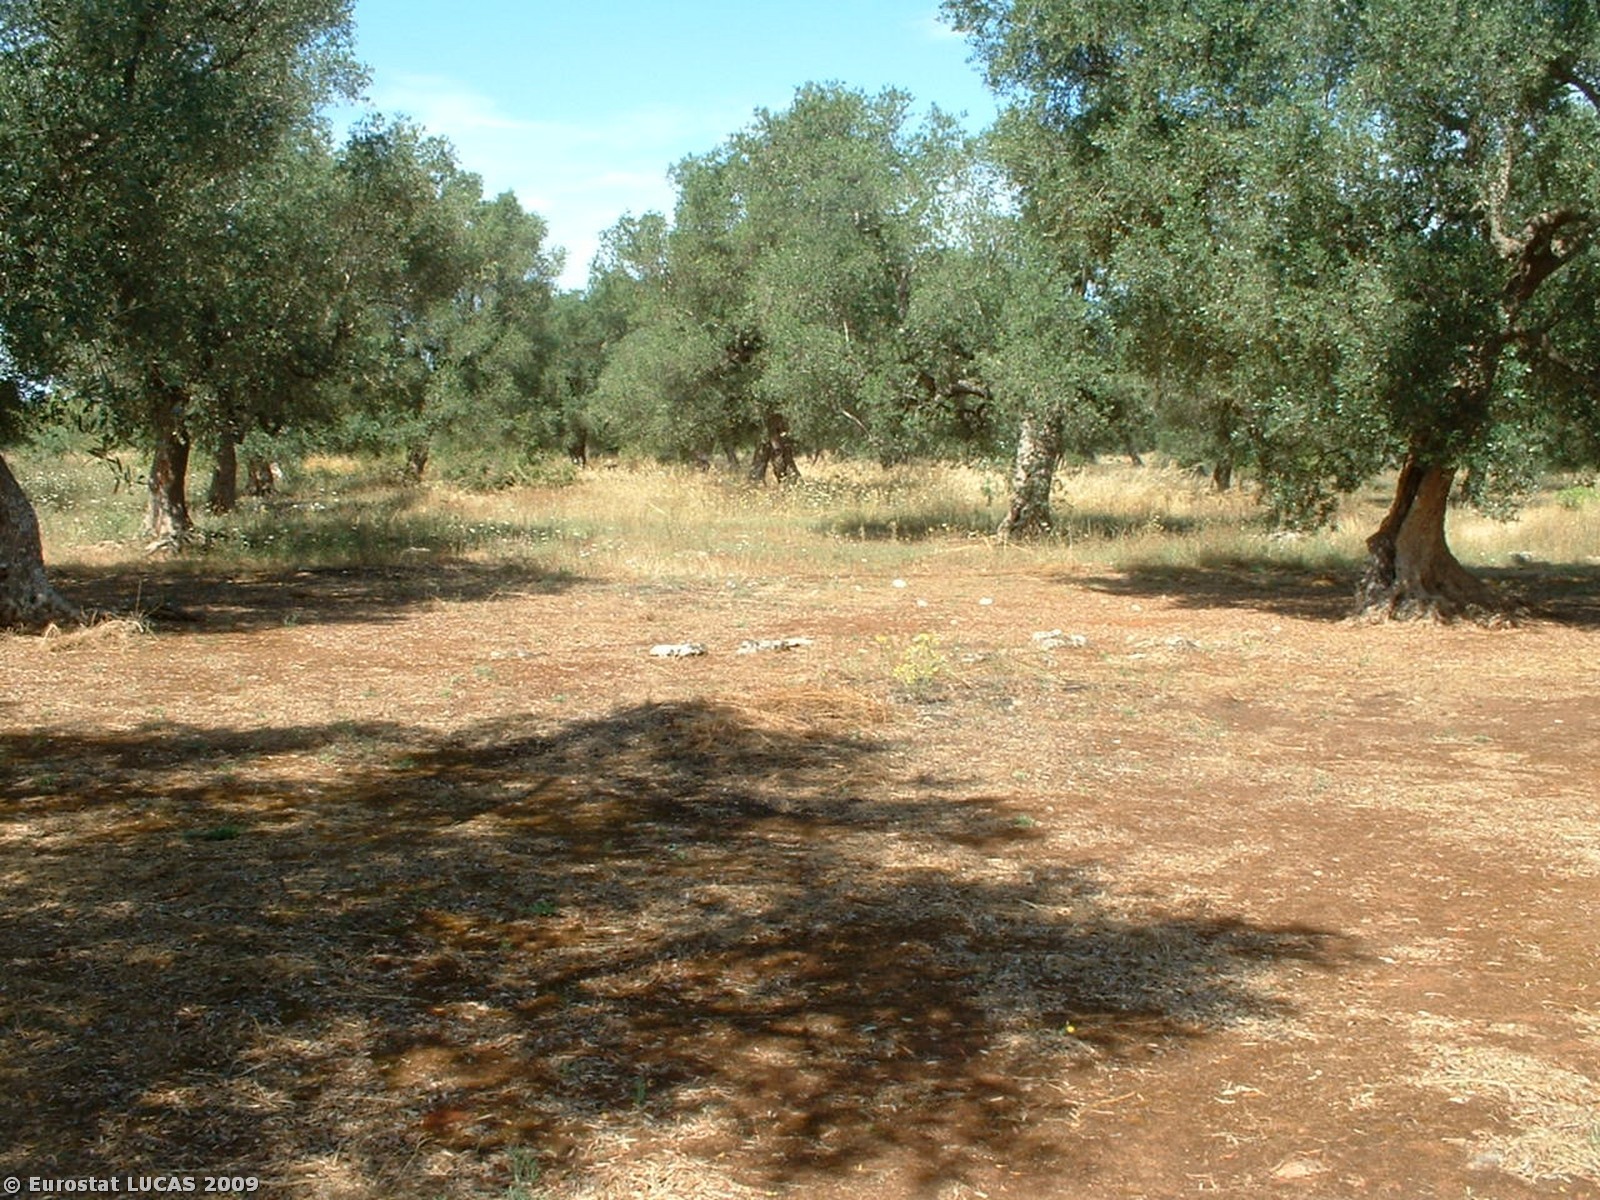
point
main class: Cropland
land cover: Olive groves
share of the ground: 50 - 75 %
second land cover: Spontaneously vegetated surfaces
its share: 50 - 75 %
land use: Agriculture (excluding fallow land and kitchen gardens)
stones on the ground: < 10 %
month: May
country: IT
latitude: 40.1134
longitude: 18.1043
